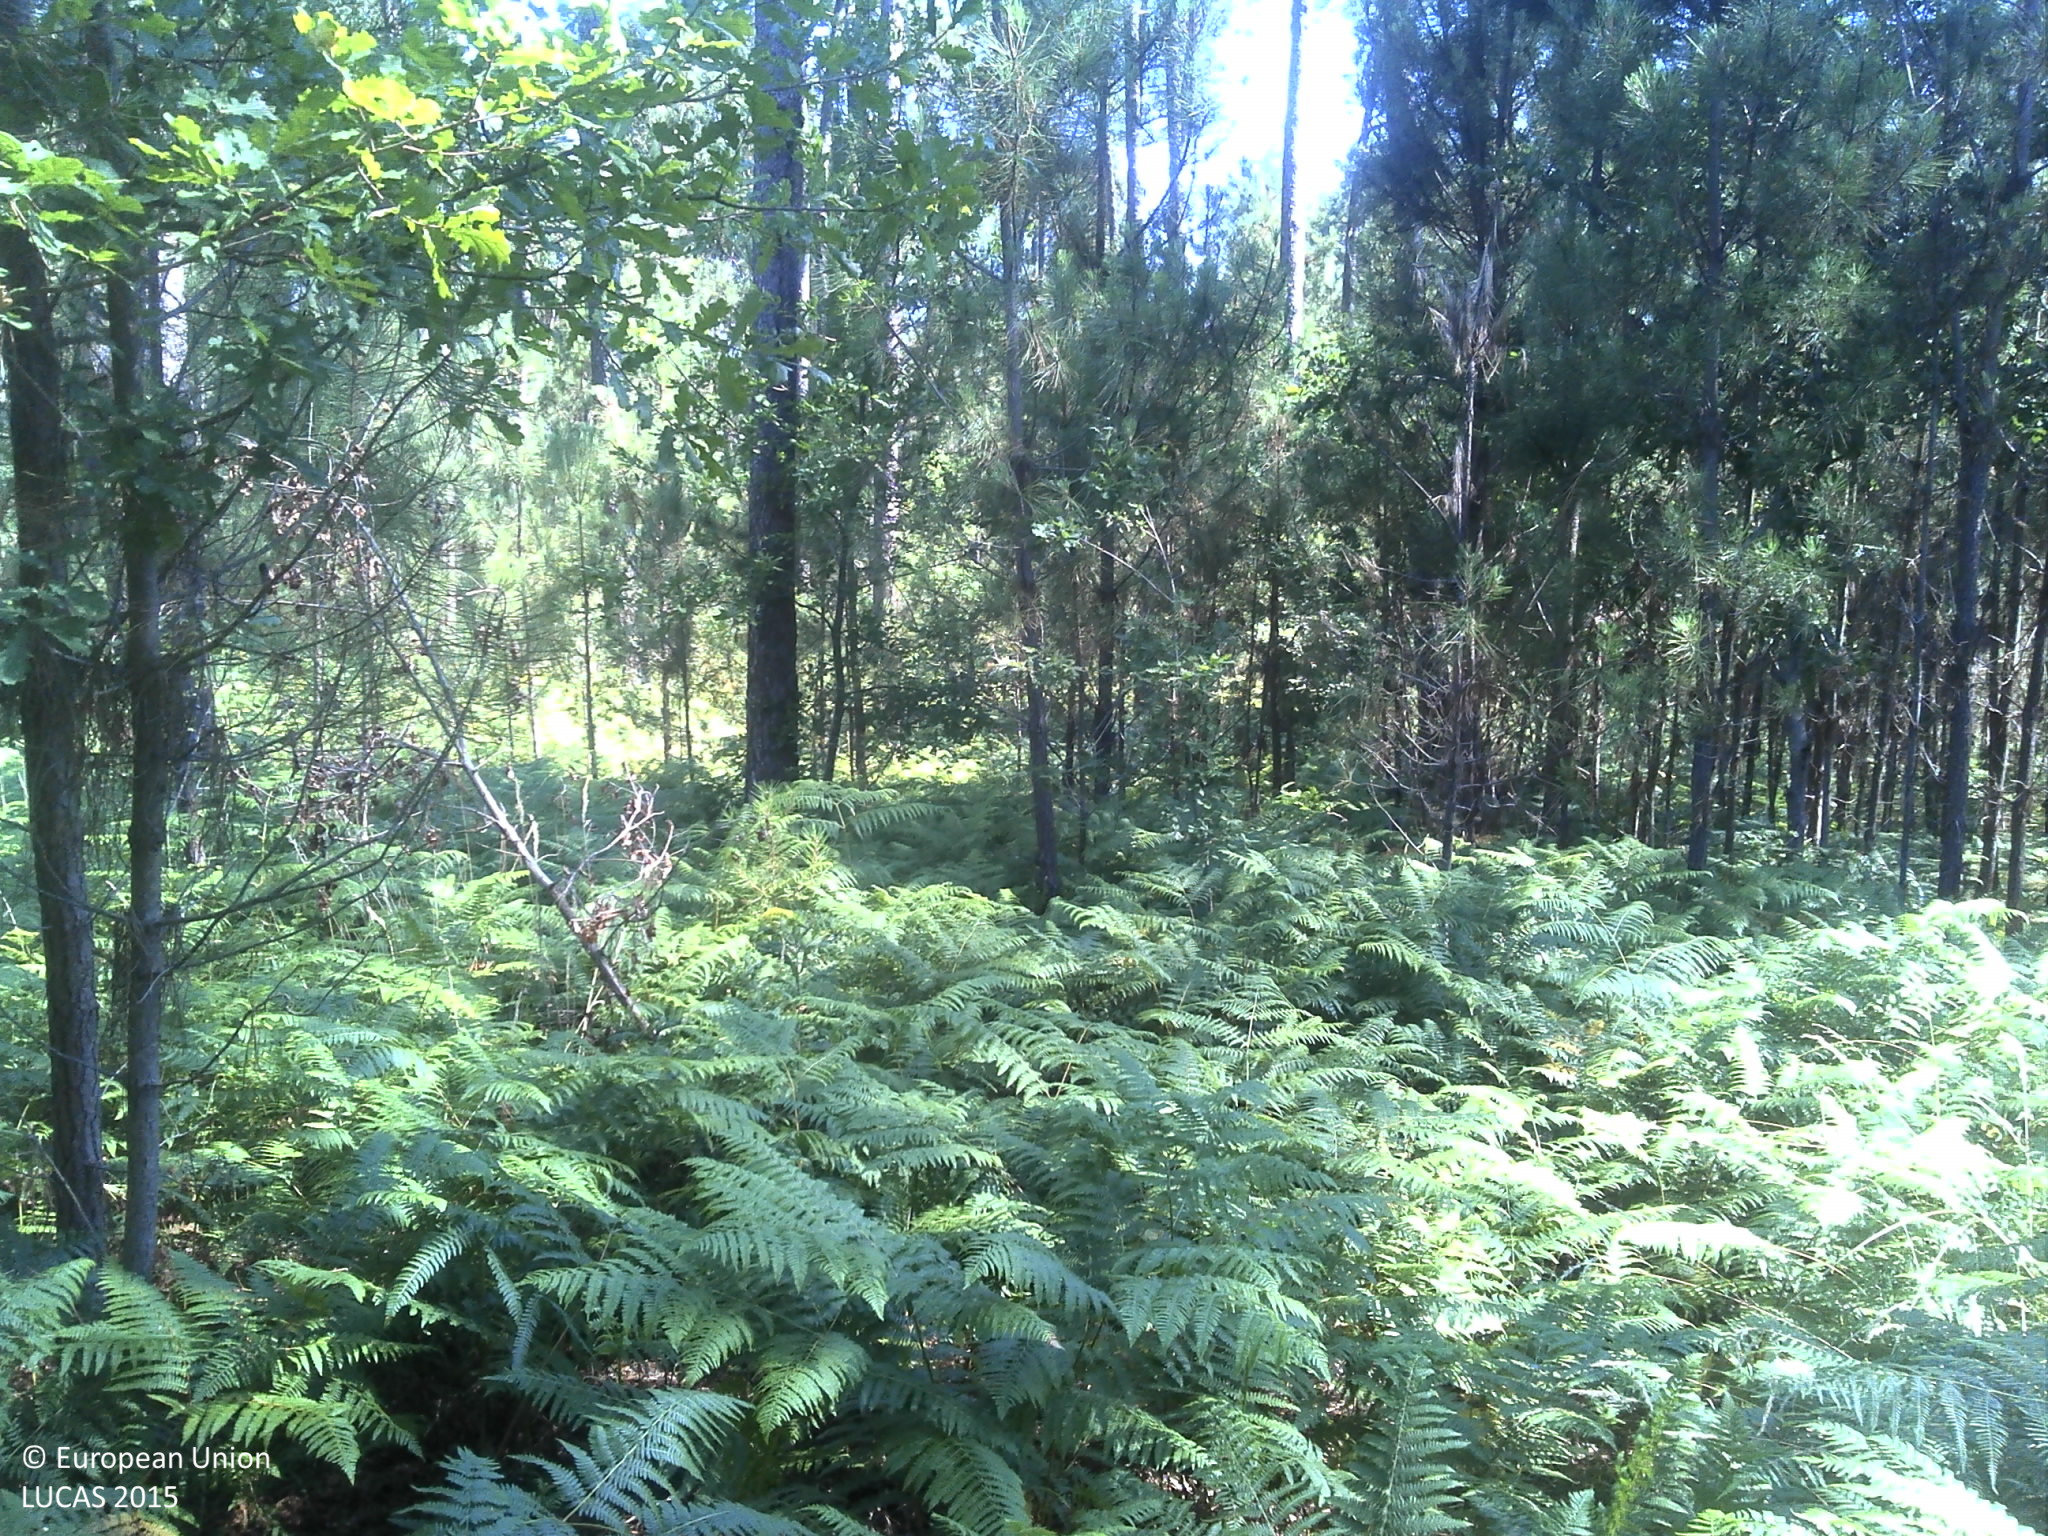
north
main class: Woodland
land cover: Pine dominated coniferous woodland
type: coniferous forest of the mediterranean region
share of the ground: 50 - 75 %
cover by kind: coniferous forest trees 65 %, shrubs 30 %, unconsolidated bare surface 5 %
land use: Forestry
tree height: > 5 m
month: June
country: PT
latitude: 41.3917
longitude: -8.1176
